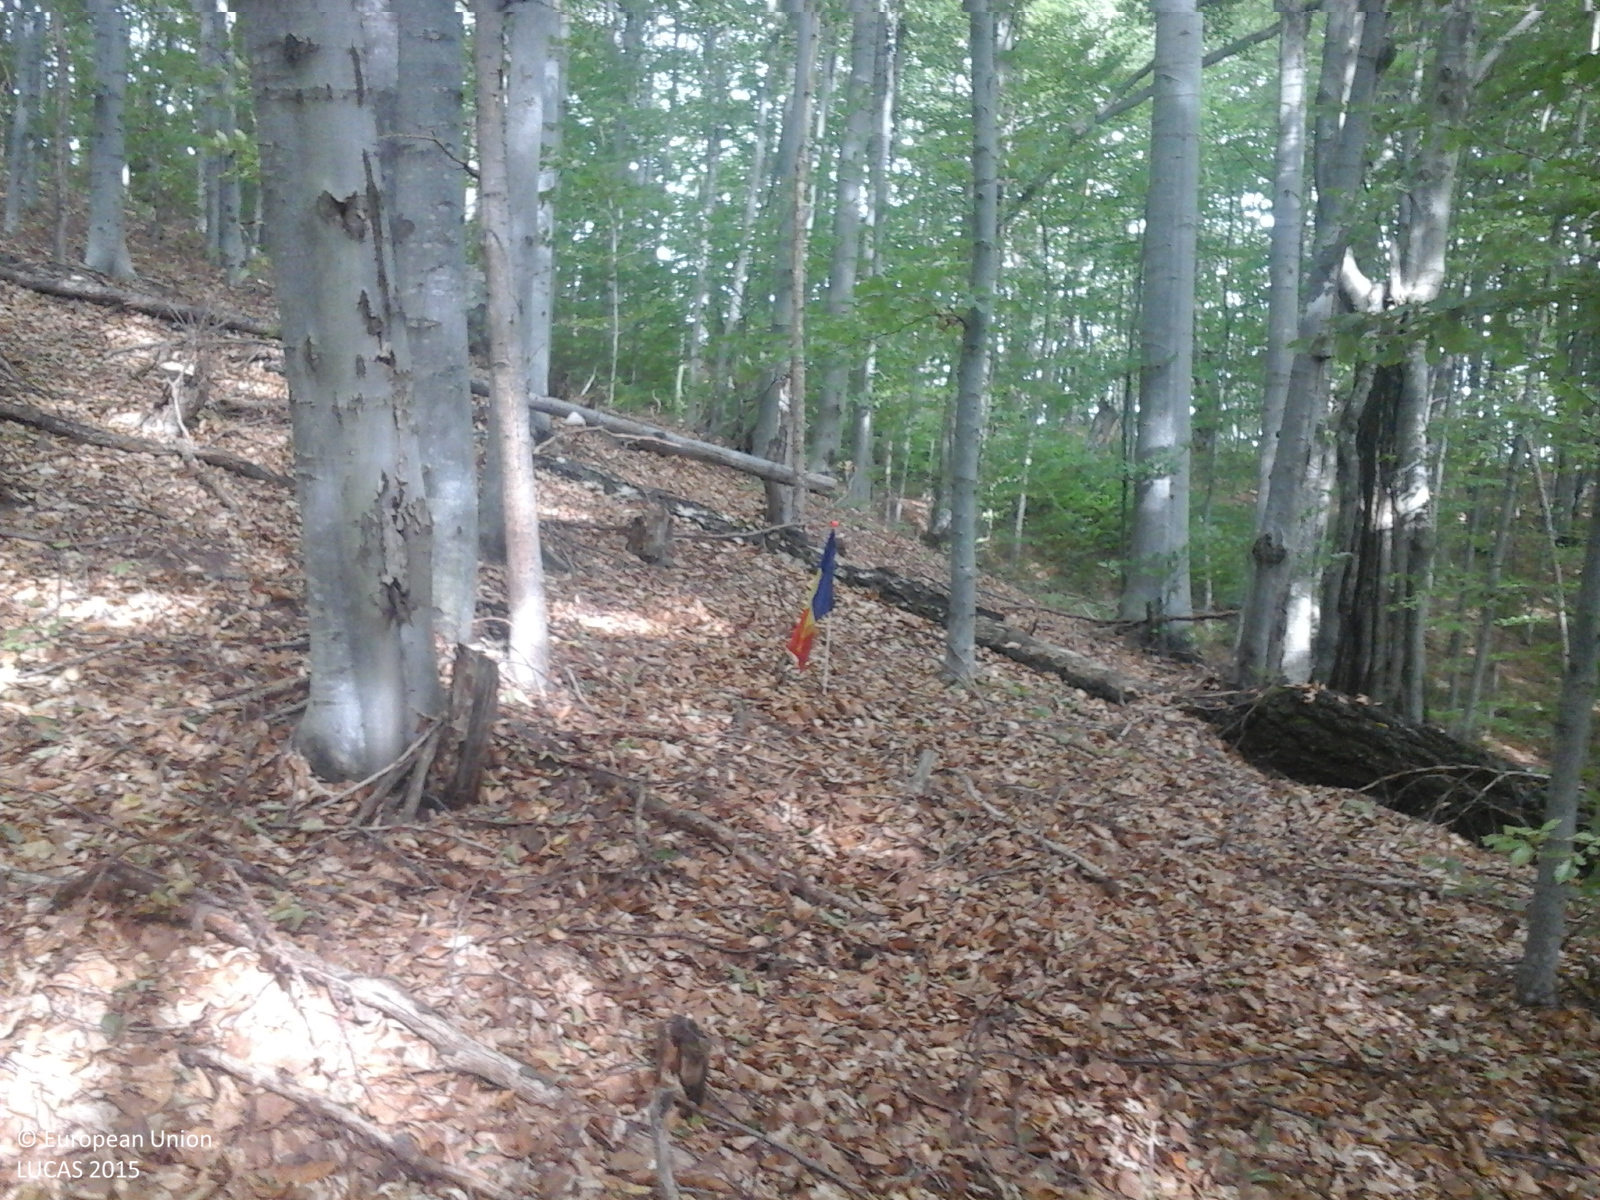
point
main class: Woodland
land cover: Broadleaved woodland
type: mesophytic deciduous forest
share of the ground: > 75 %
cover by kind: broadleaved forest trees 100 %
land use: Forestry
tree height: > 5 m
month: September
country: RO
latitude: 47.3756
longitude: 24.0290
